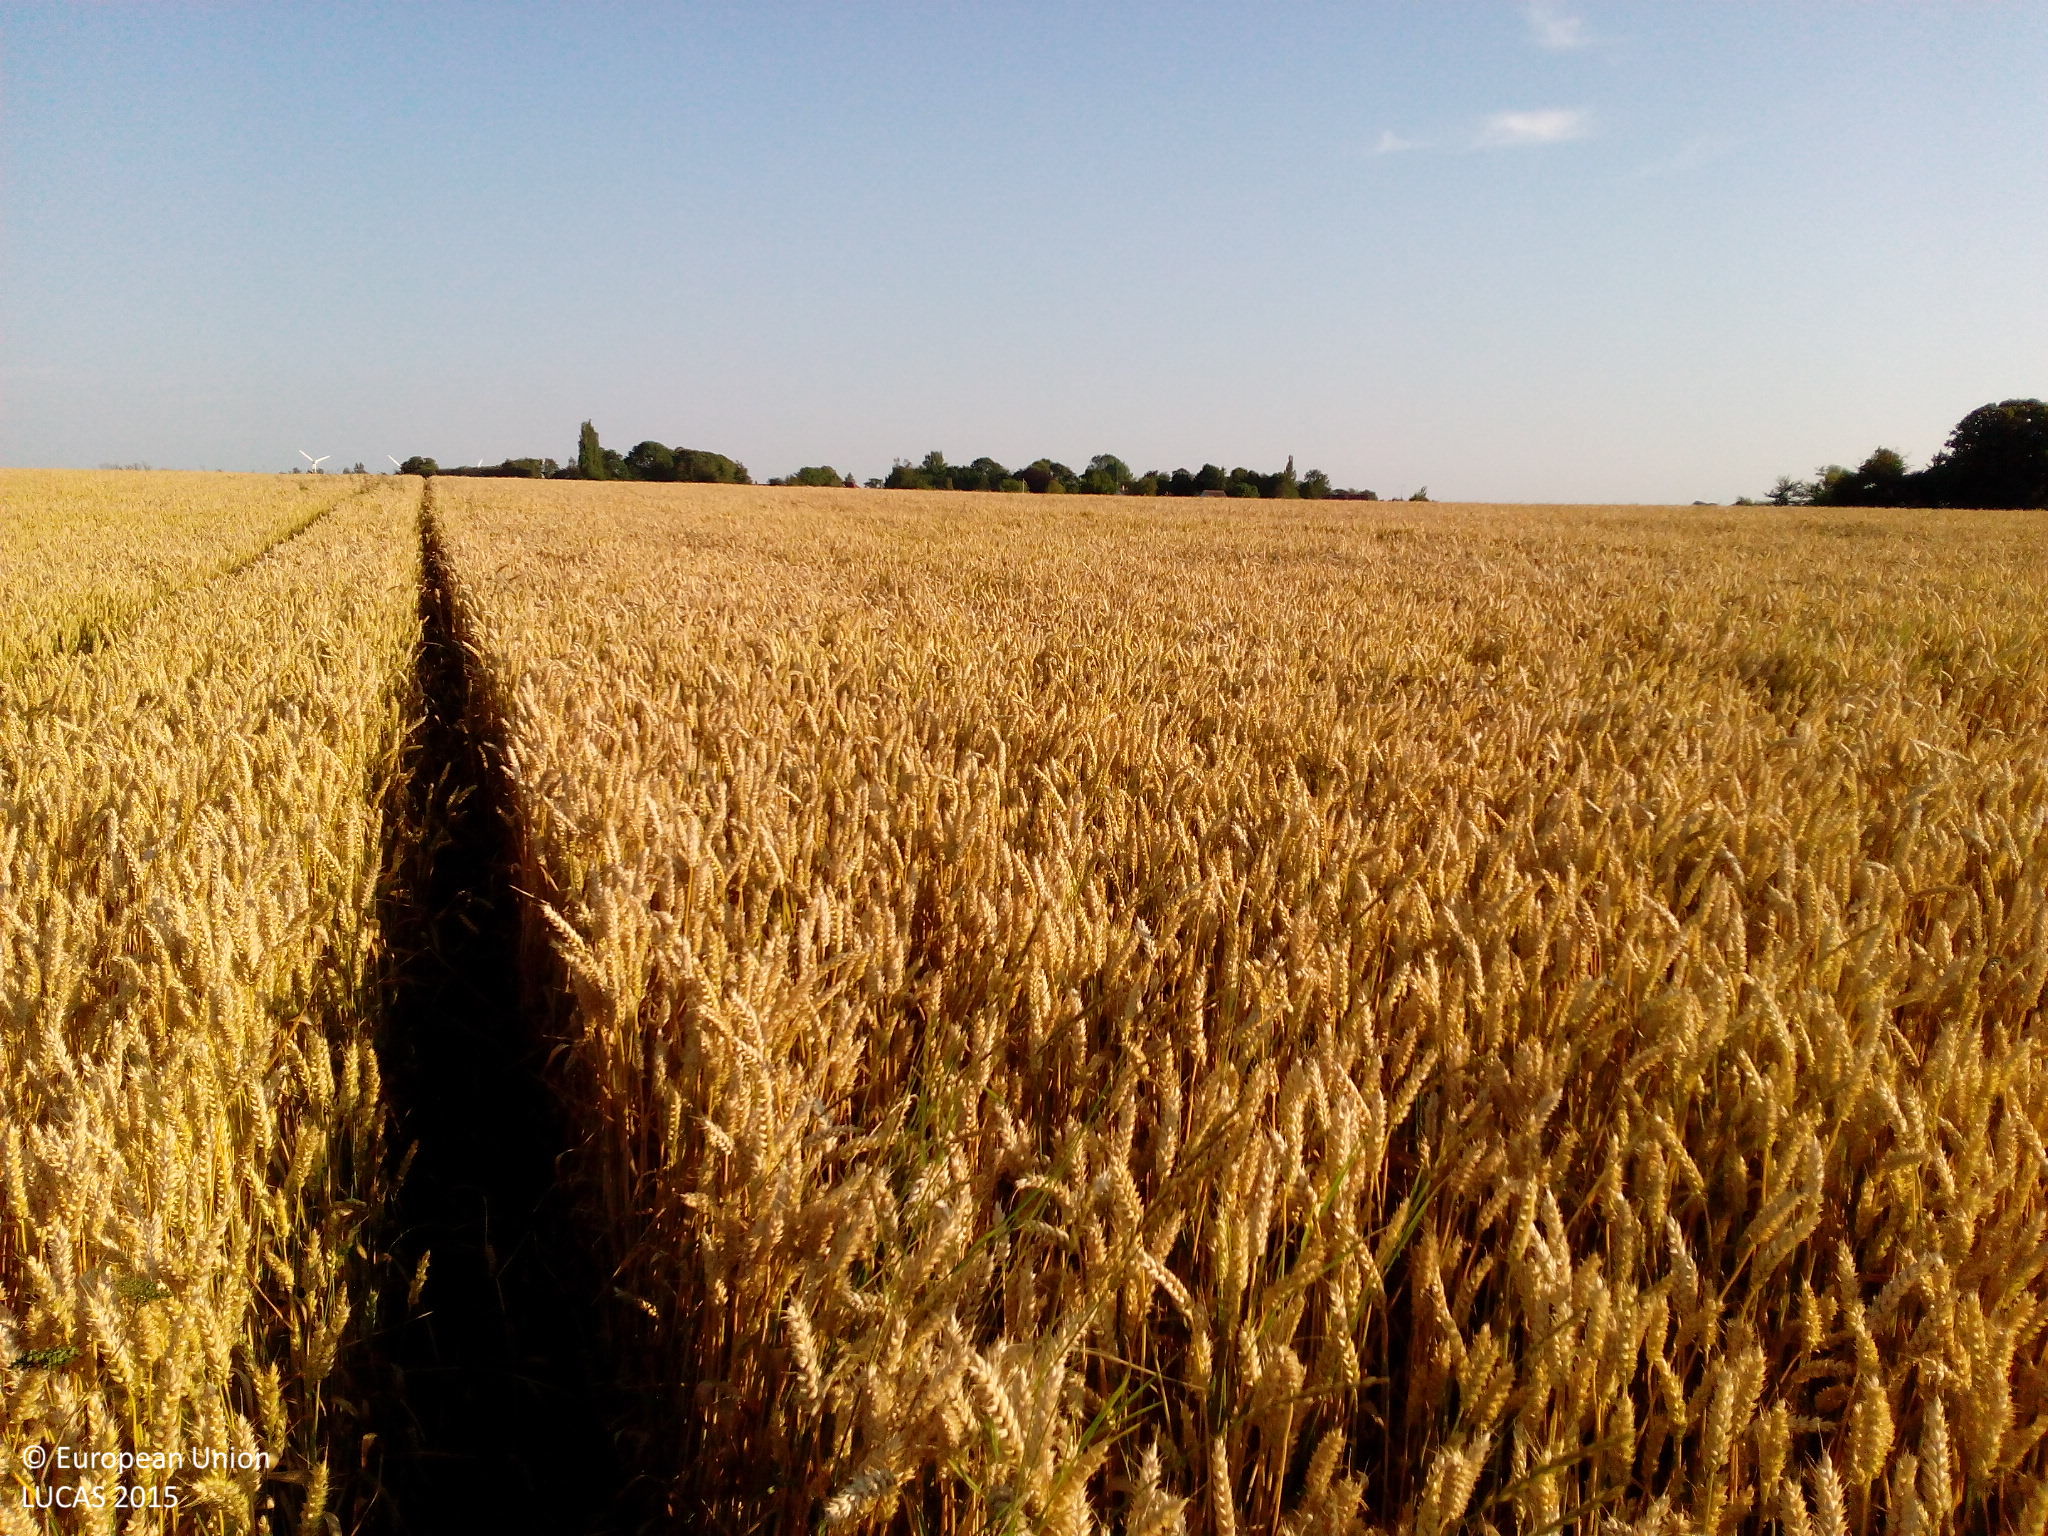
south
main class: Cropland
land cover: Common wheat
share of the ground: > 75 %
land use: Agriculture (excluding fallow land and kitchen gardens)
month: August
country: DK
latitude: 55.6884
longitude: 11.8912
